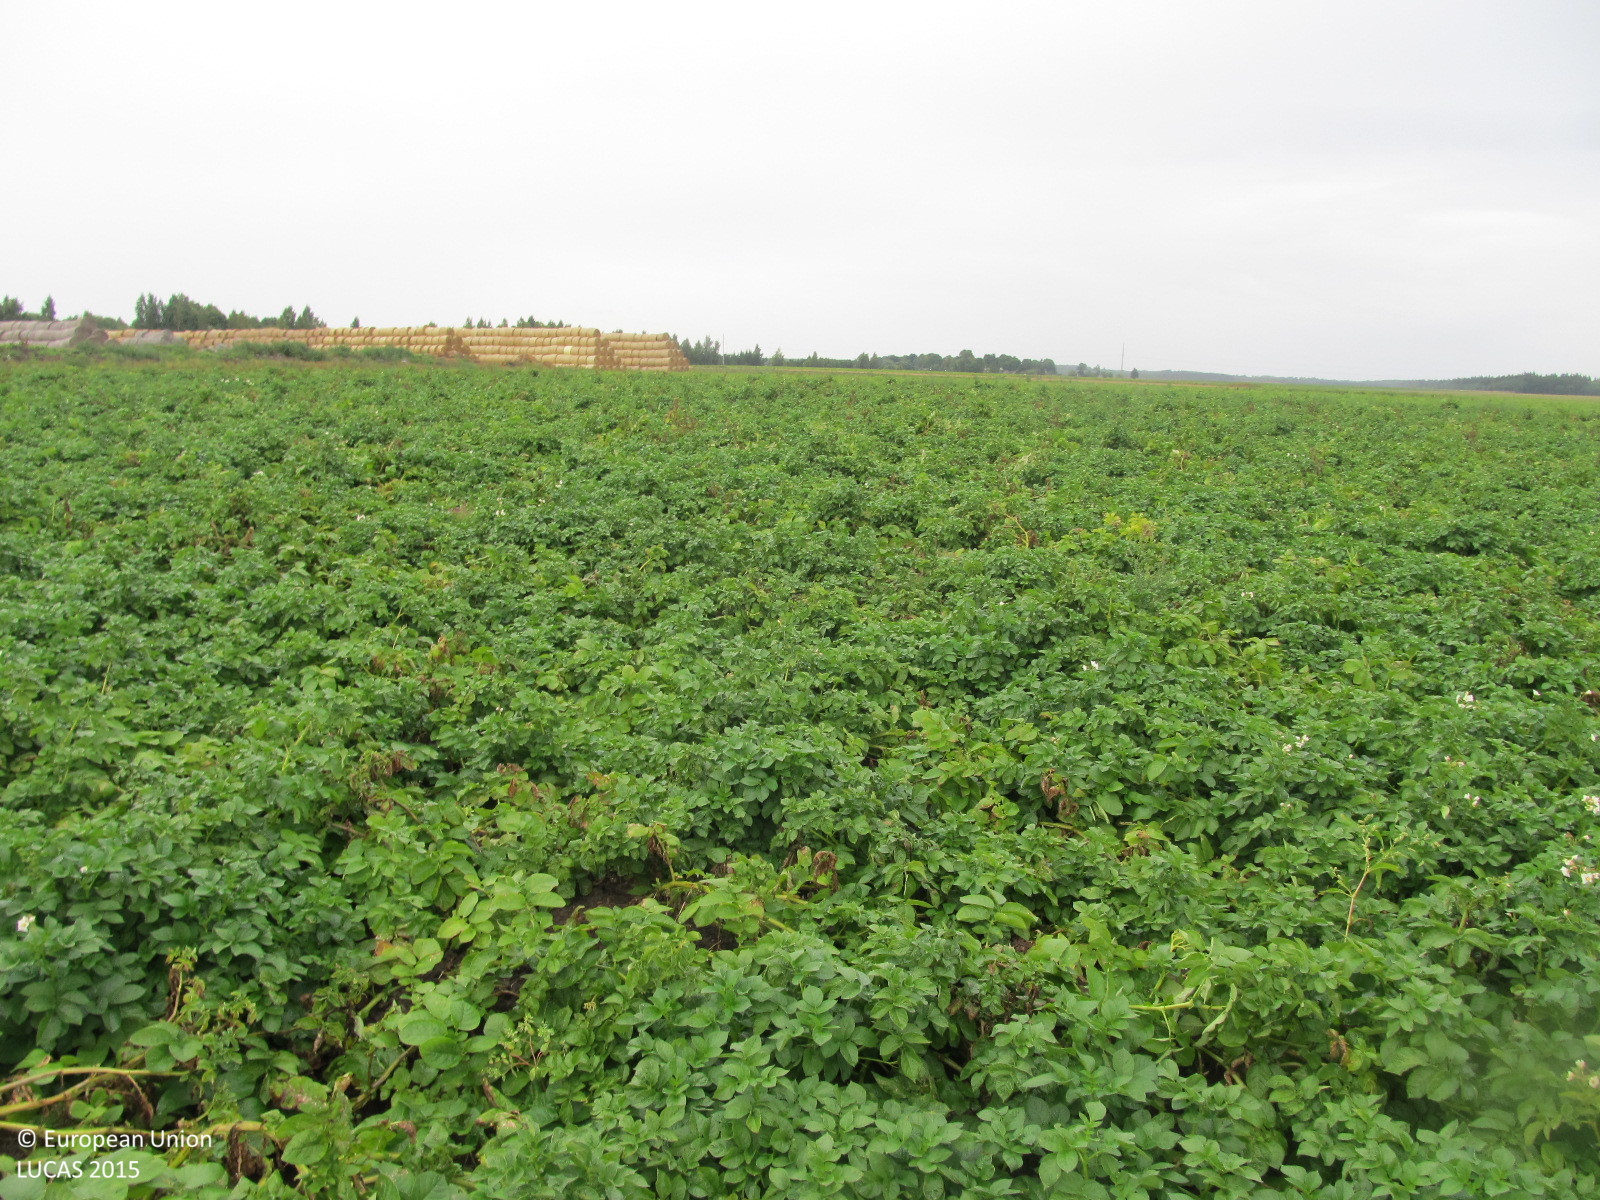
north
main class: Cropland
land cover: Potatoes
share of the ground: > 75 %
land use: Agriculture (excluding fallow land and kitchen gardens)
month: September
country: LT
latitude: 56.1177
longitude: 23.2444
